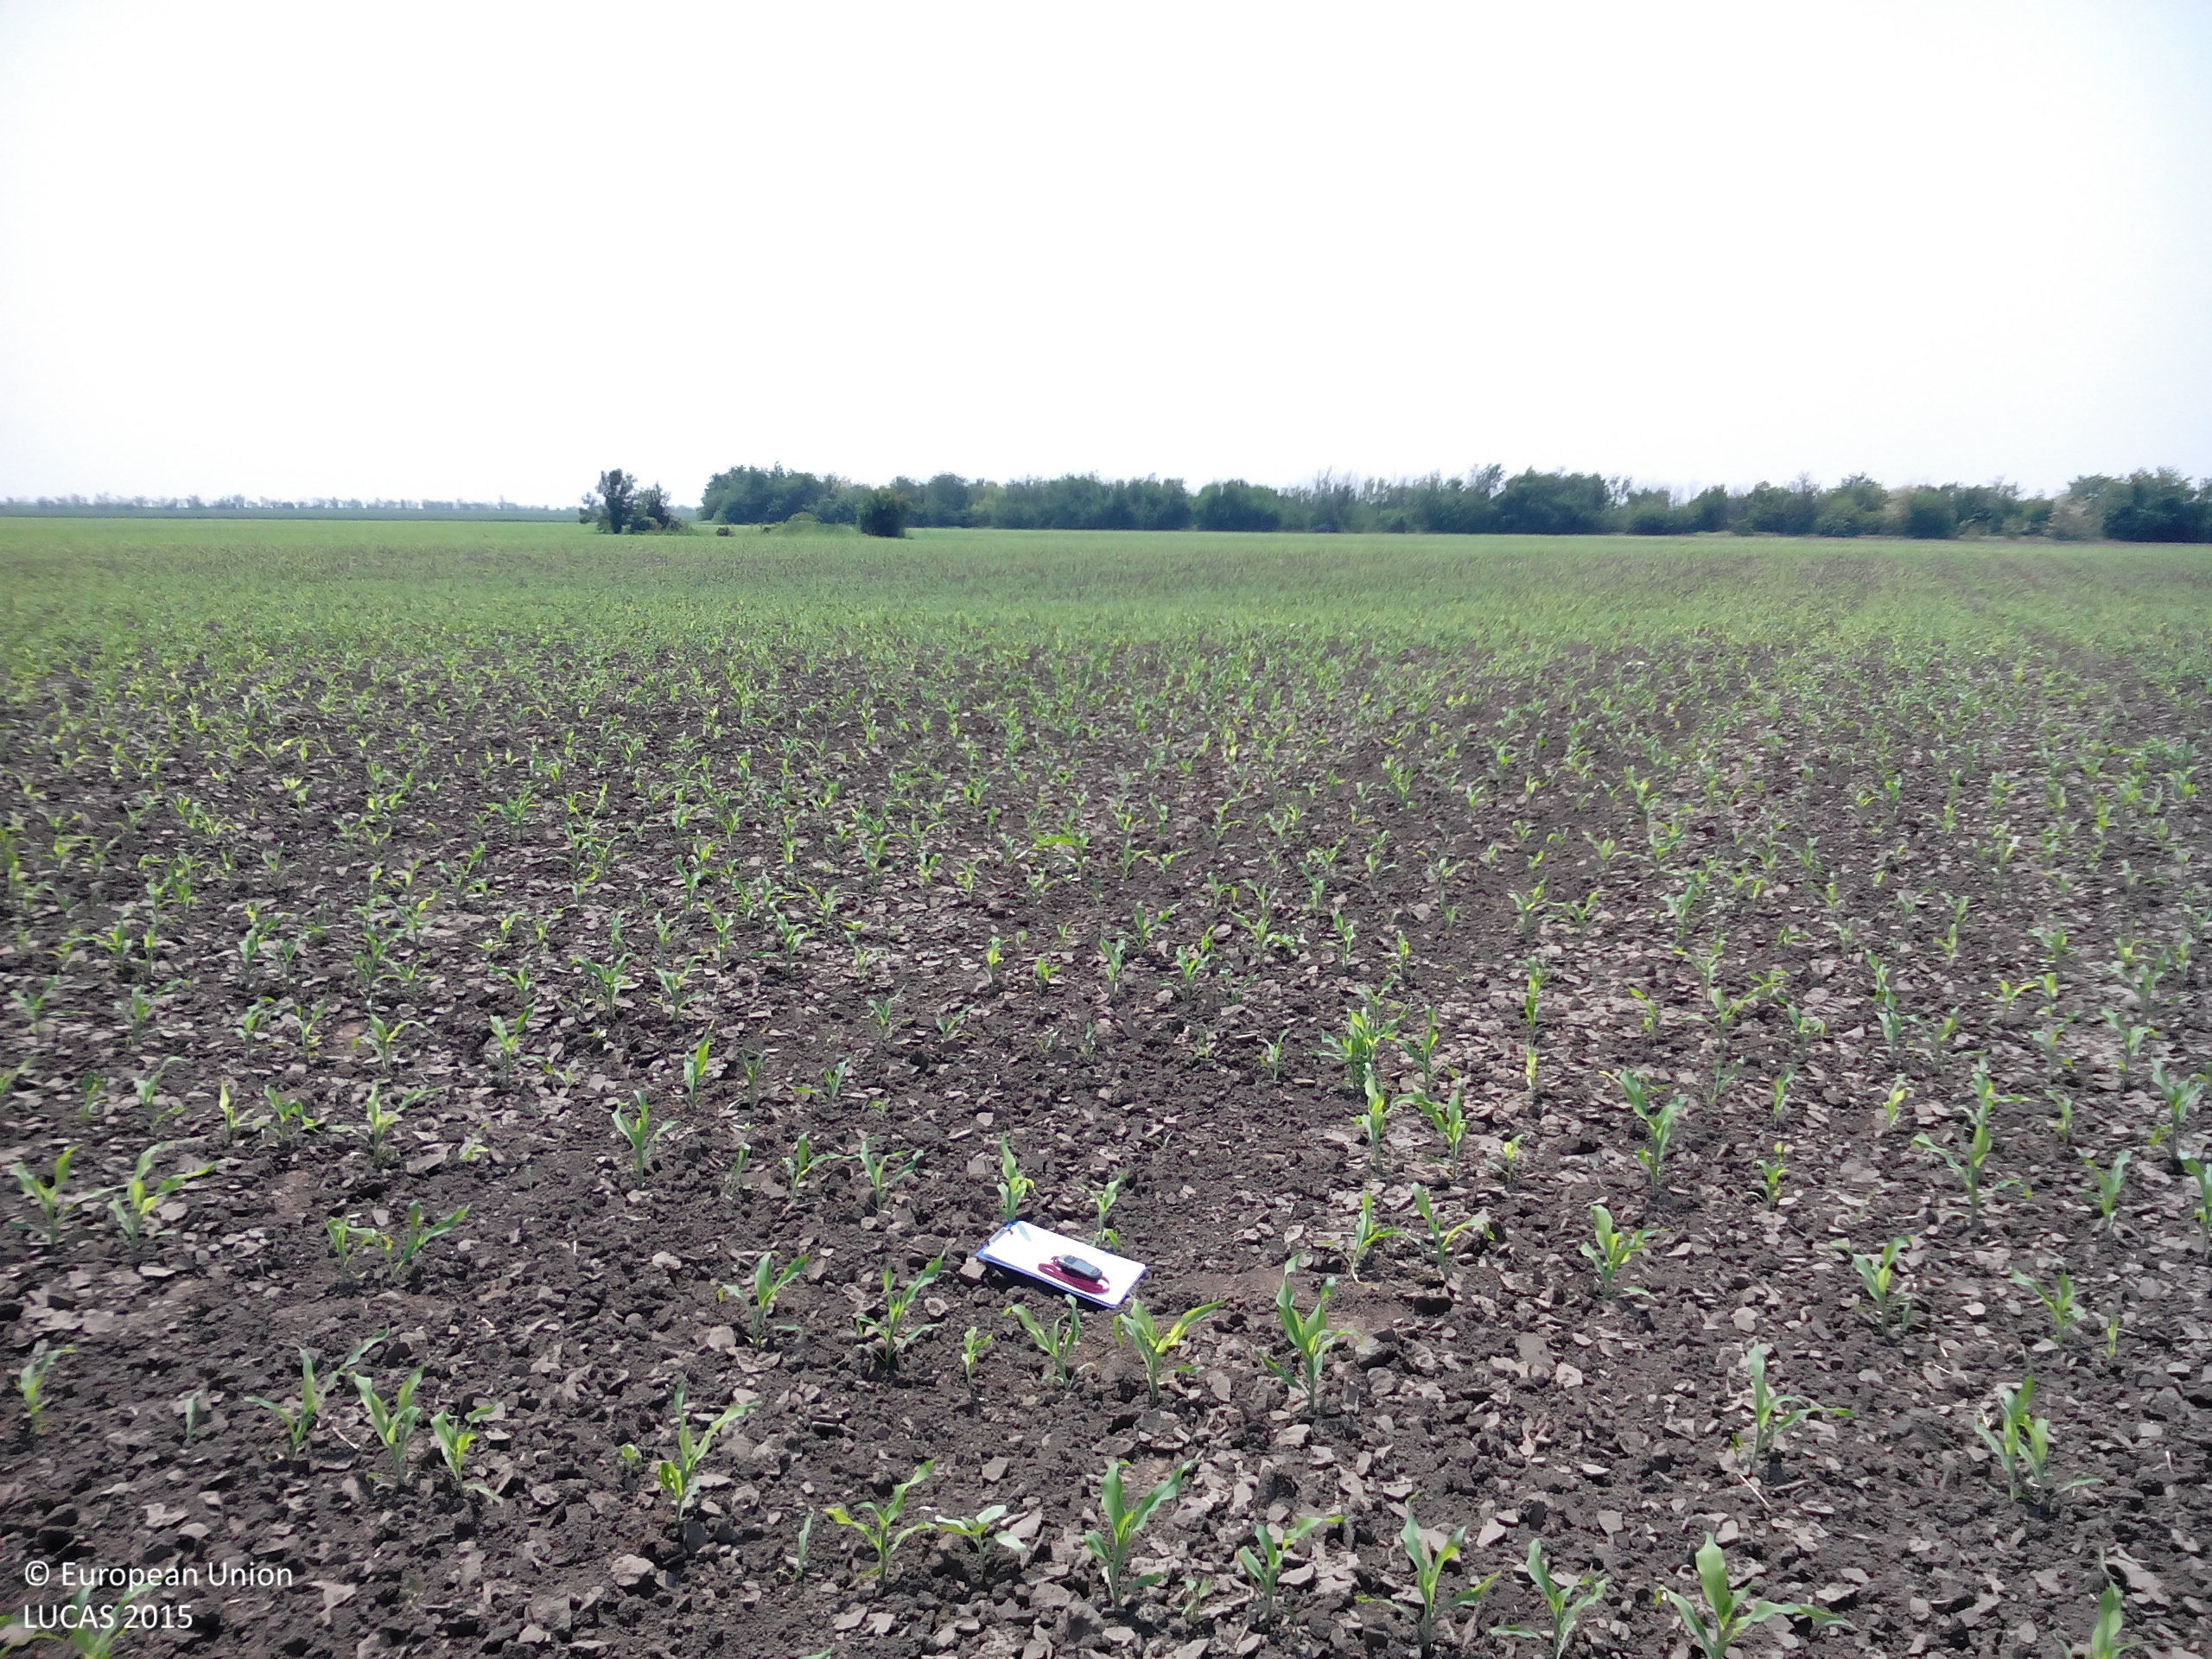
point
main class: Cropland
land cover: Maize
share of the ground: 10 - 25 %
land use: Agriculture (excluding fallow land and kitchen gardens)
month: May
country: BG
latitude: 43.6062
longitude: 24.0671
